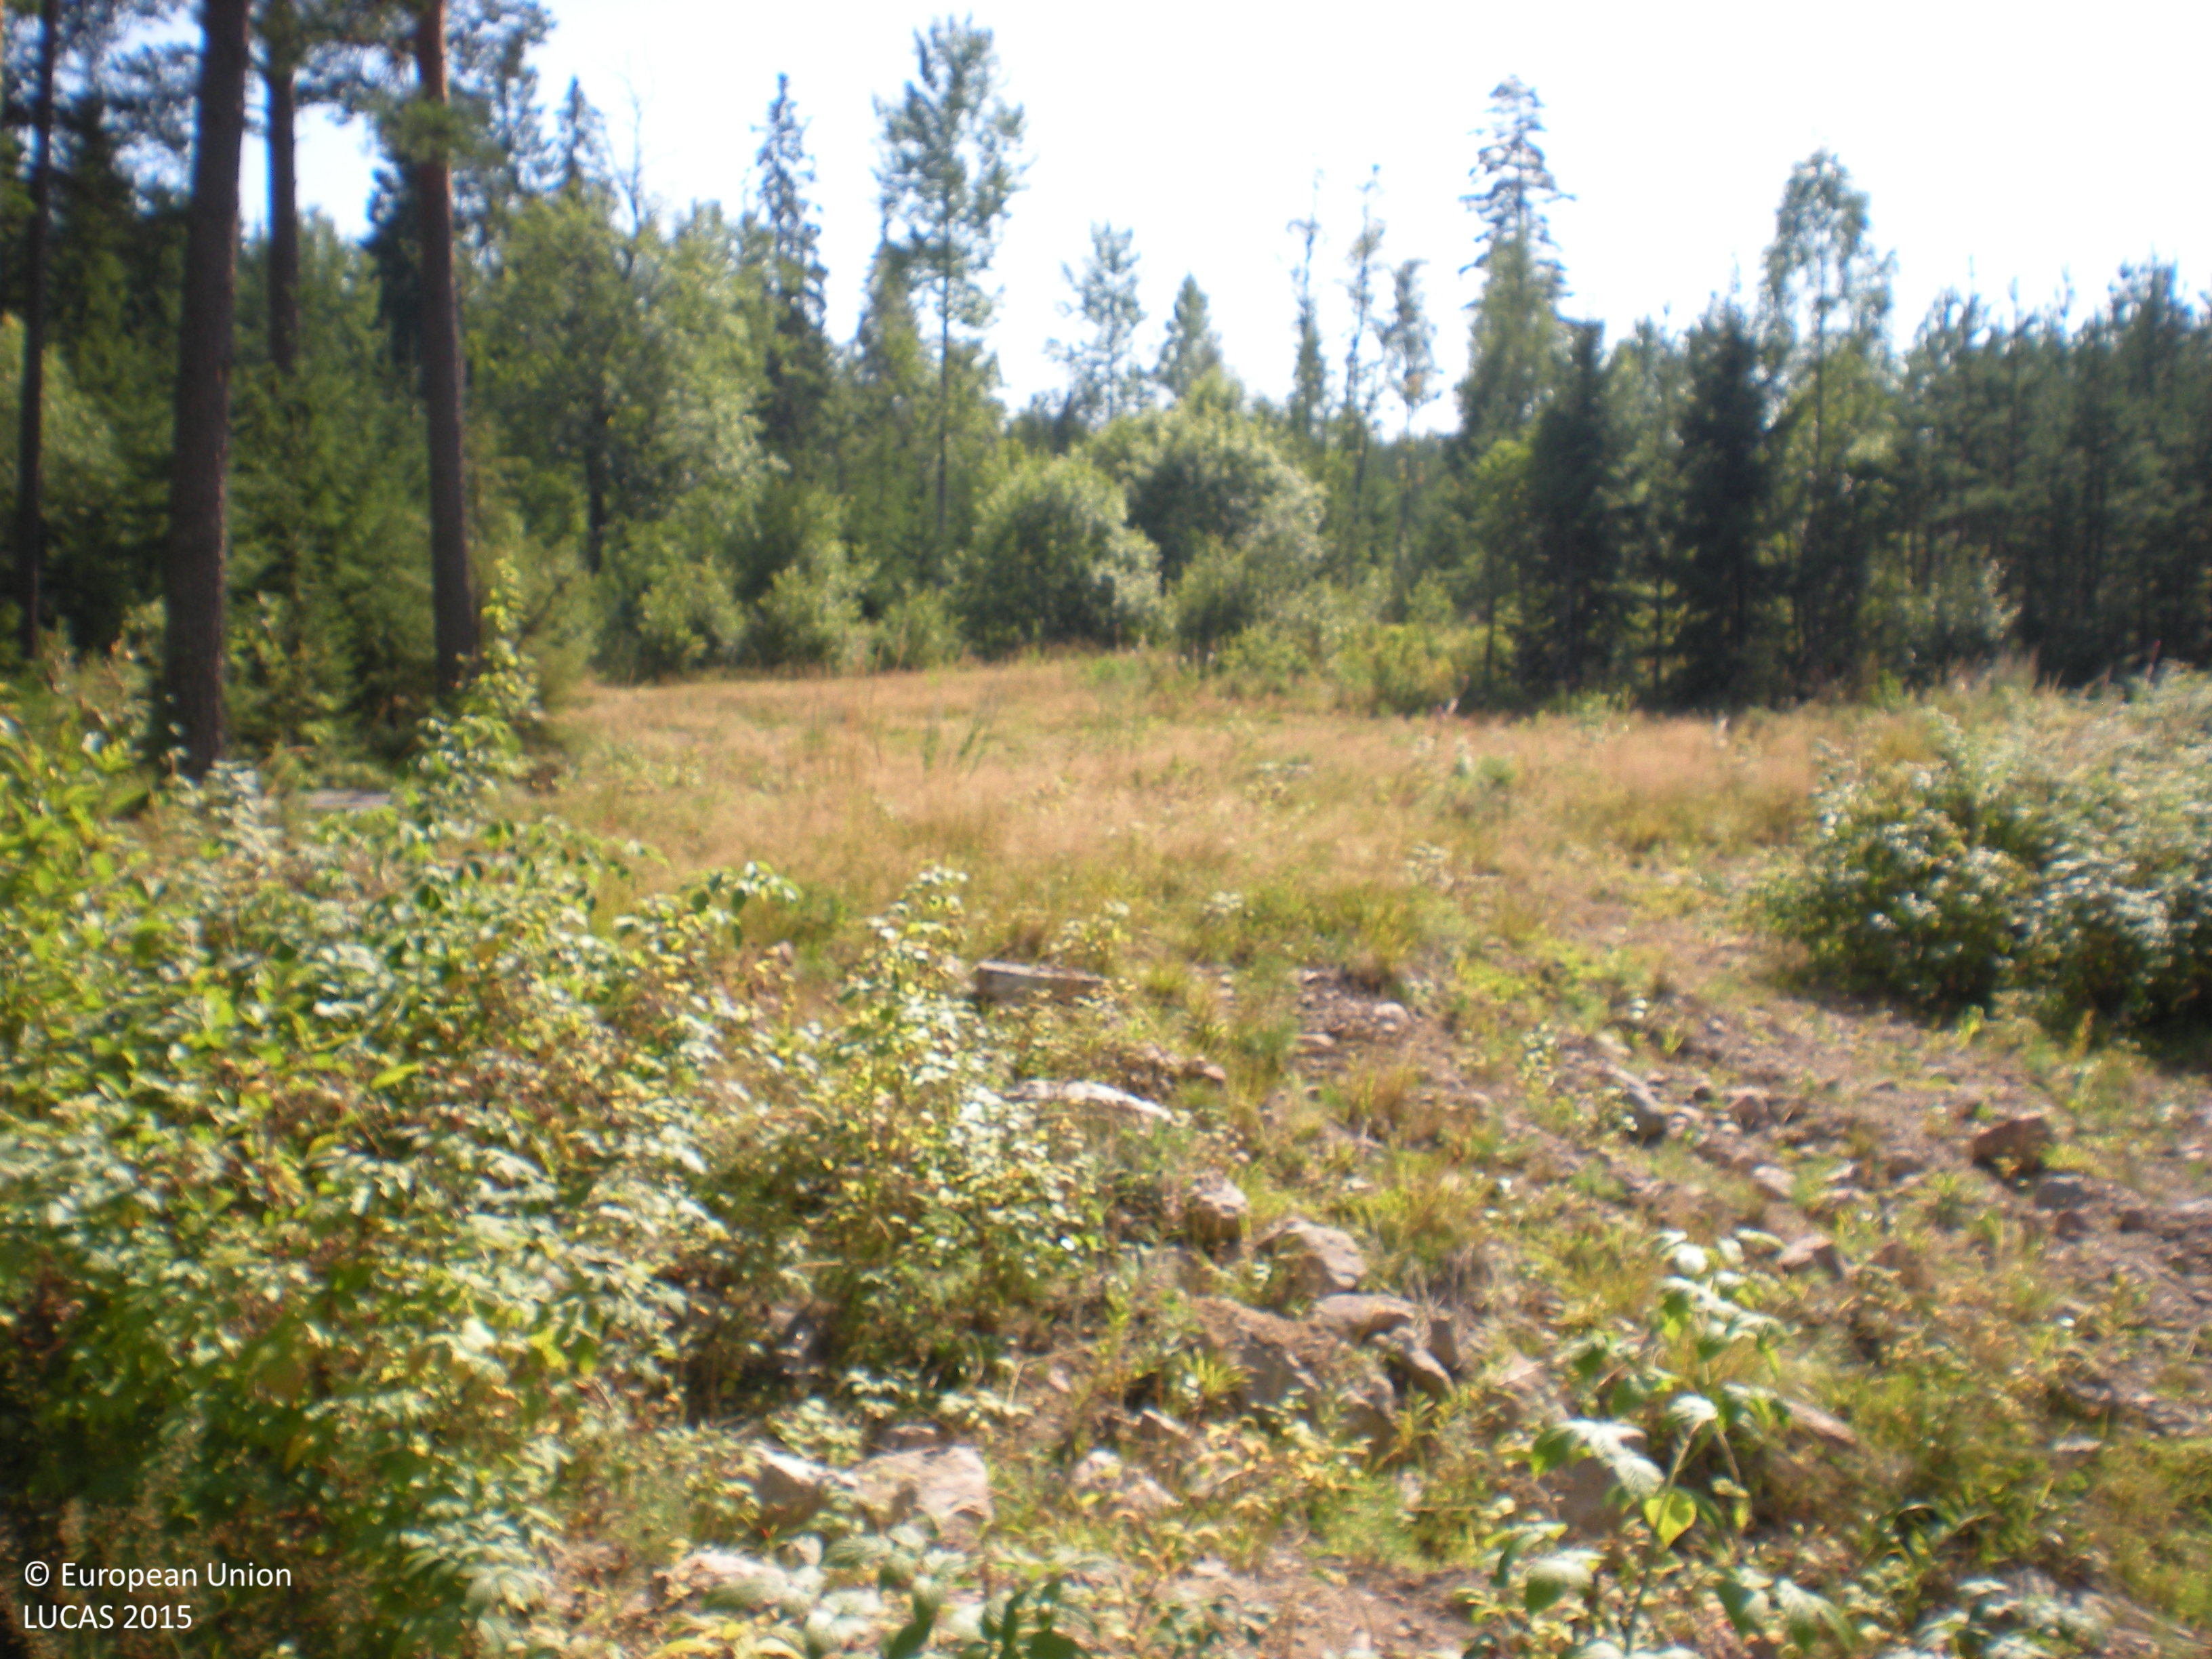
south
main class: Shrubland
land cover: Shrubland with sparse tree cover
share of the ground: 50 - 75 %
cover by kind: shrubs 60 %, unconsolidated bare surface 15 %, herbaceous plants 10 %, consolidated bare surface 10 %, broadleaved forest trees 5 %
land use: Forestry
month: August
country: SE
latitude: 60.6257
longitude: 17.2819
